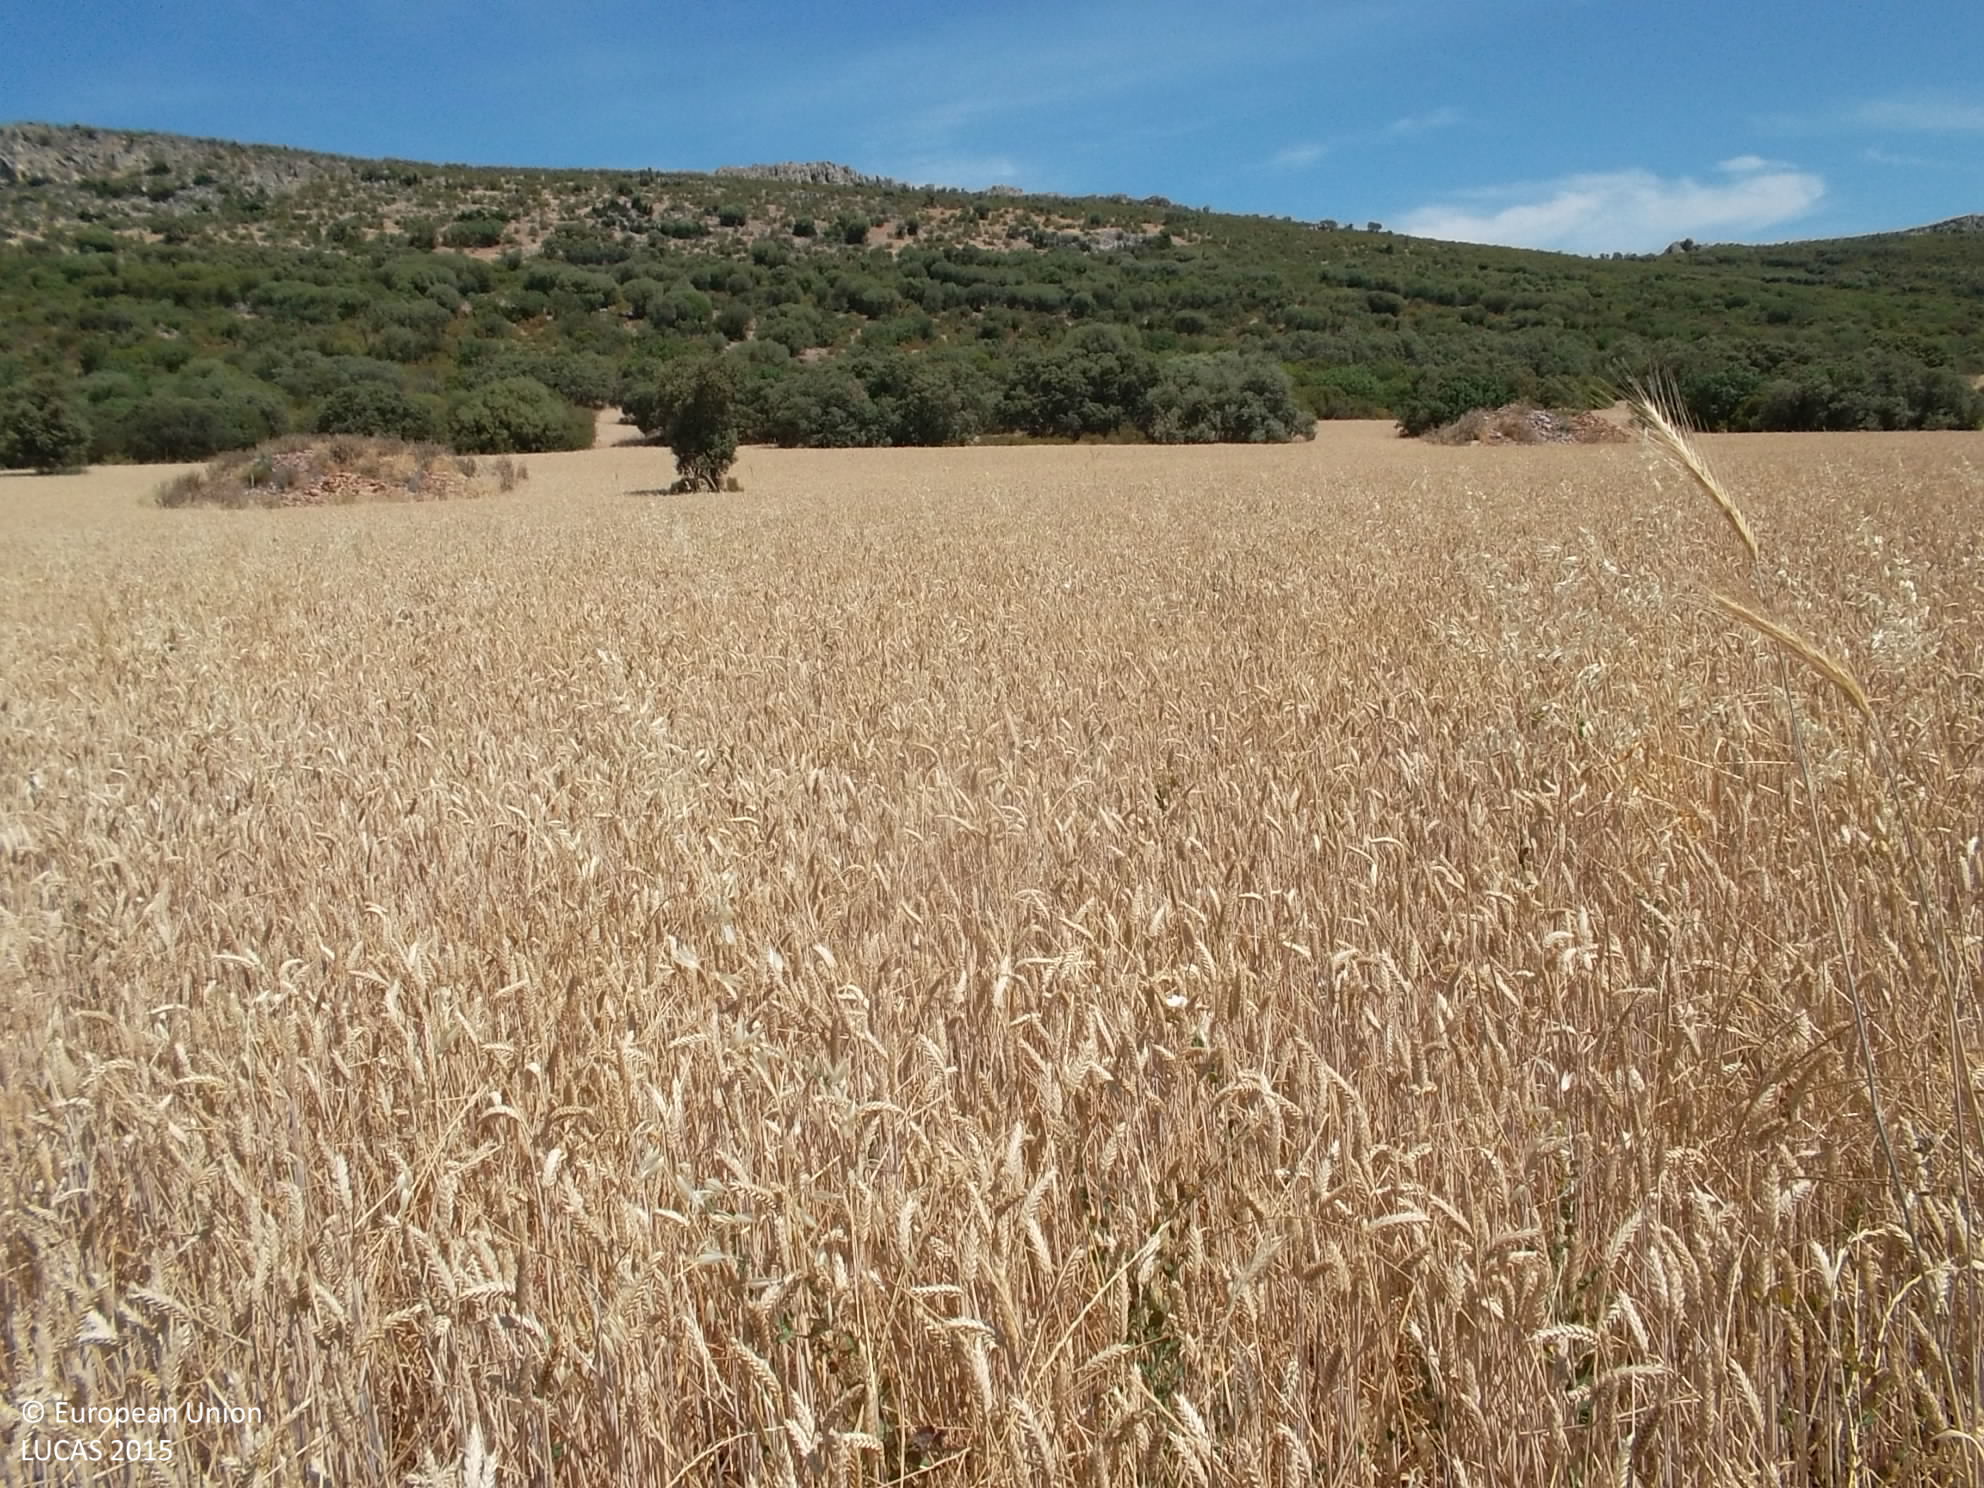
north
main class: Cropland
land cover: Common wheat
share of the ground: > 75 %
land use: Agriculture (excluding fallow land and kitchen gardens)
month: June
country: ES
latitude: 39.0617
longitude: -4.0882
